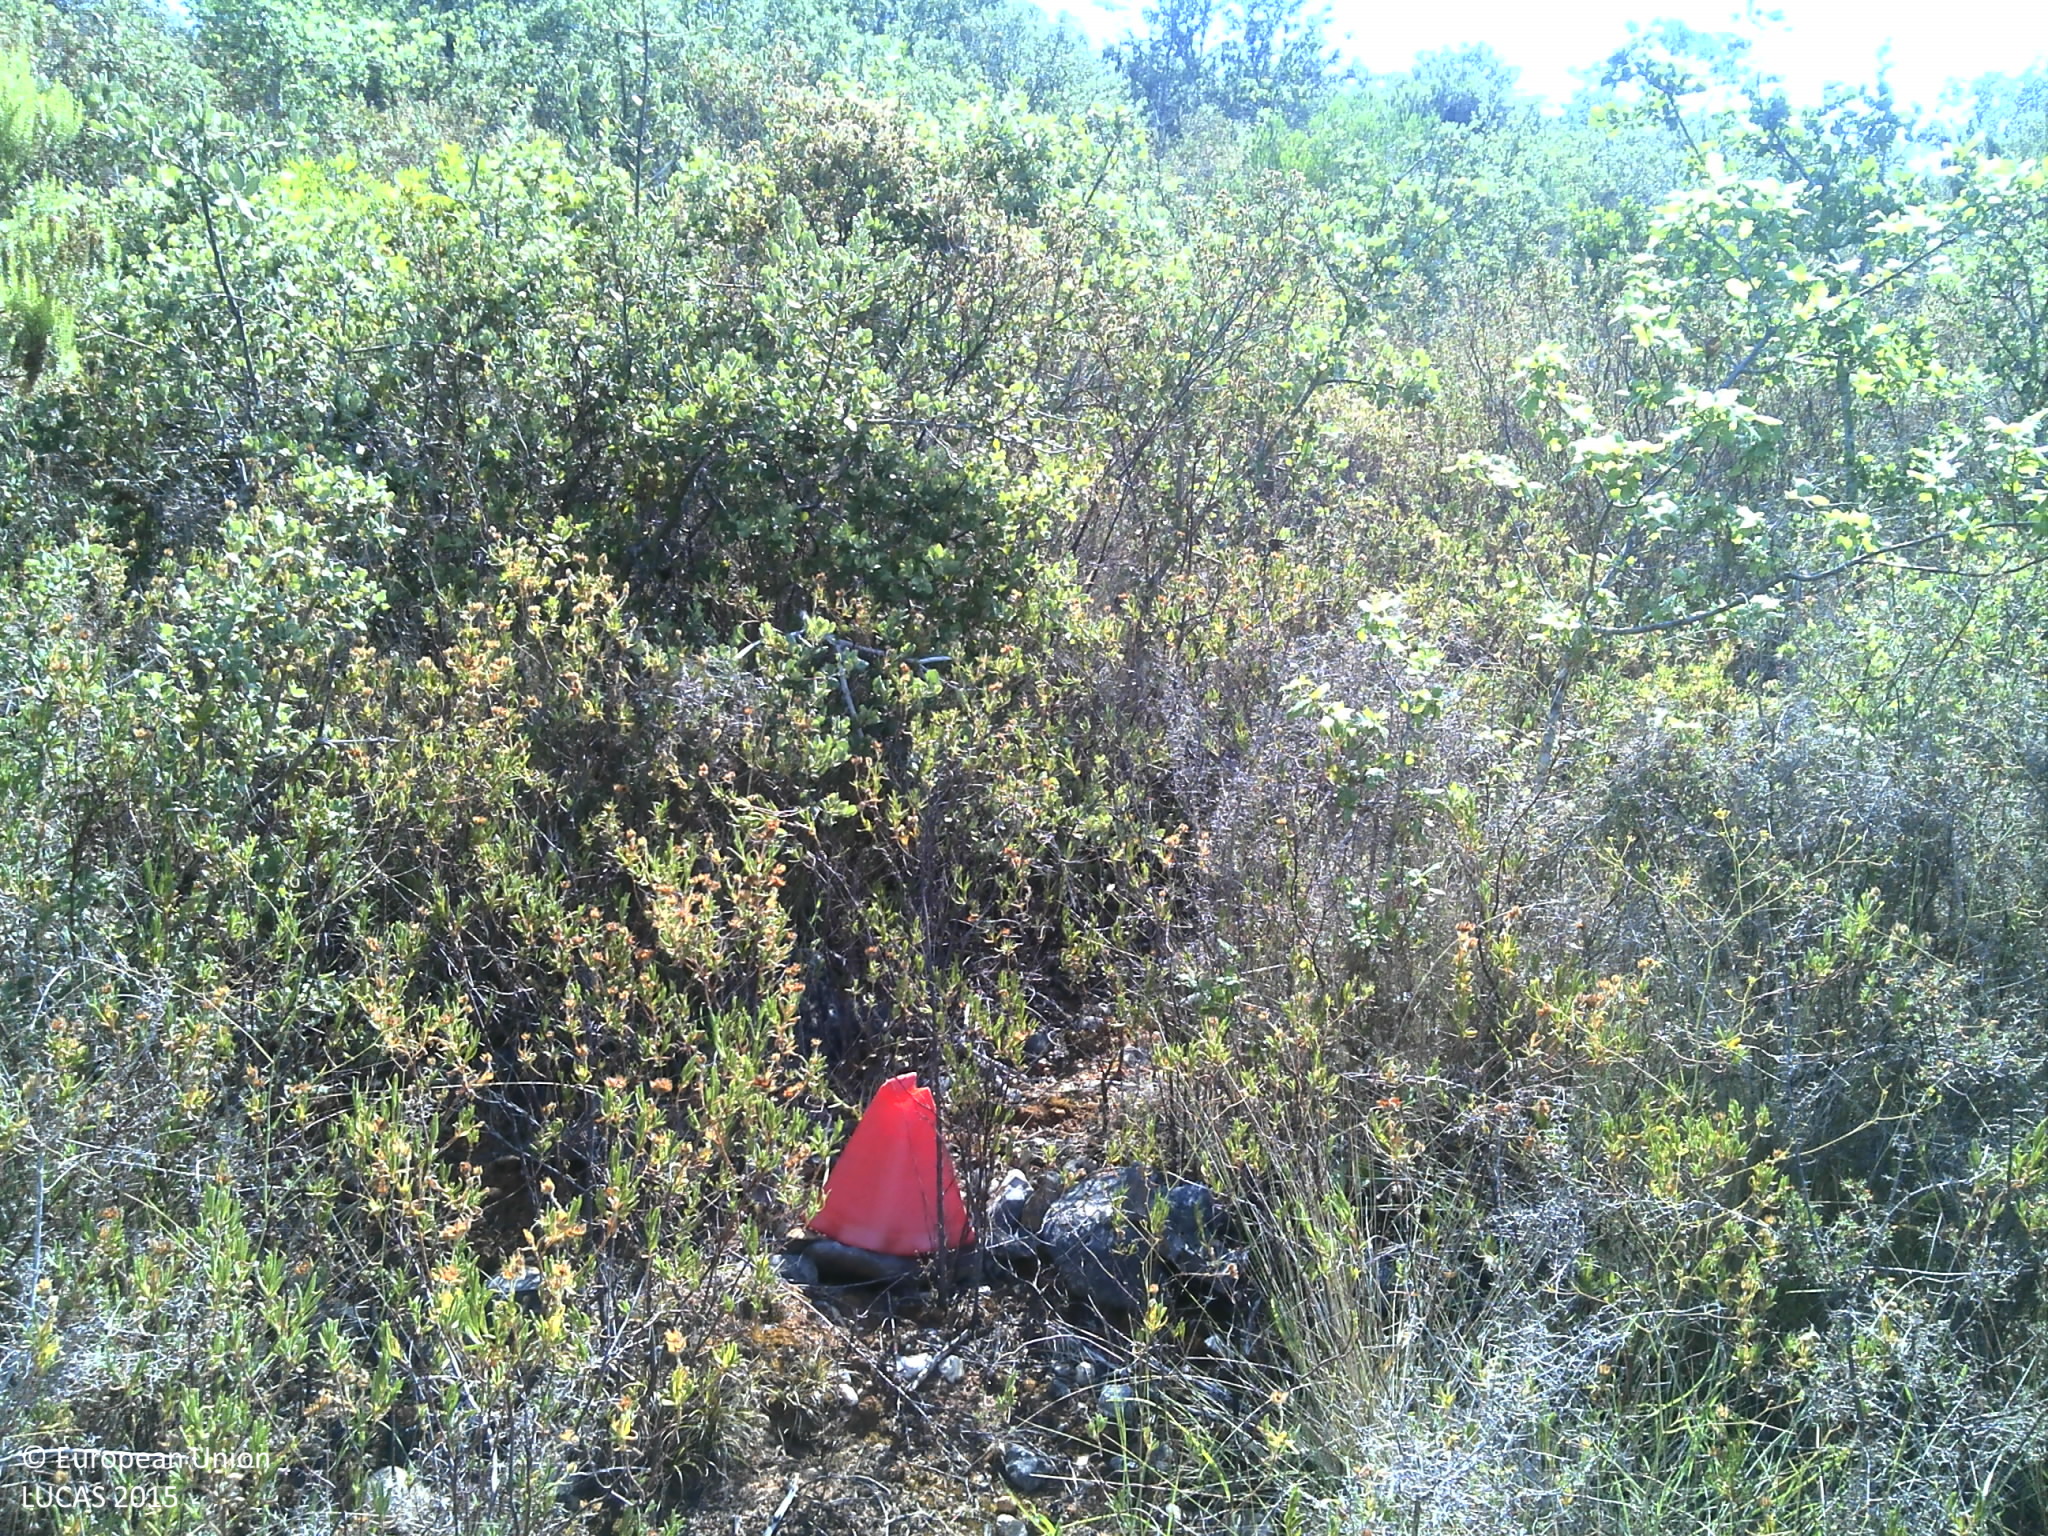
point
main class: Woodland
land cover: Broadleaved woodland
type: broadleaved evergreen forest
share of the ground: 25 - 50 %
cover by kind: shrubs 50 %, broadleaved forest trees 30 %, unconsolidated bare surface 15 %, consolidated bare surface 5 %
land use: Abandoned areas
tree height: < 5 m
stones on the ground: > 50 %
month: June
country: PT
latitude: 39.7477
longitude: -8.4090
